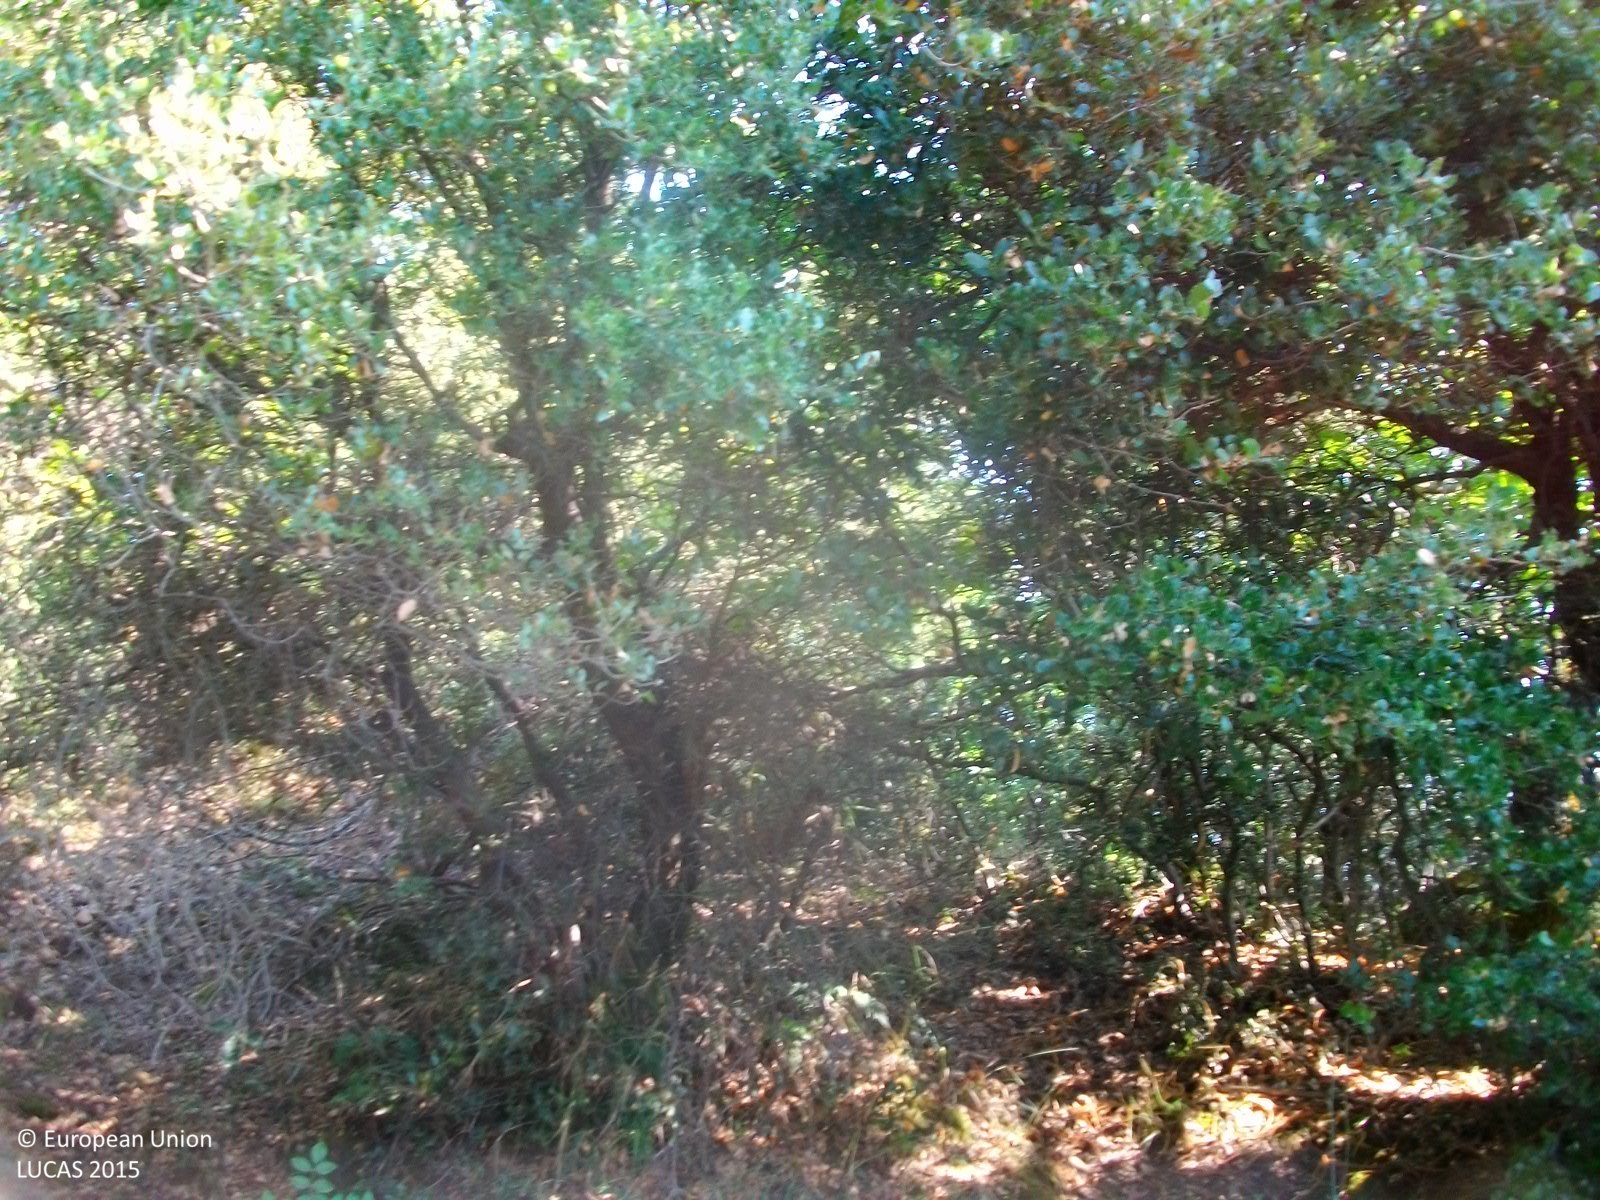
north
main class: Shrubland
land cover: Shrubland with sparse tree cover
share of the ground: > 75 %
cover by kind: shrubs 95 %, broadleaved forest trees 5 %
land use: Semi-natural and natural areas not in use
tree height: > 5 m
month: July
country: GR
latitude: 37.4308
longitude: 21.9486
